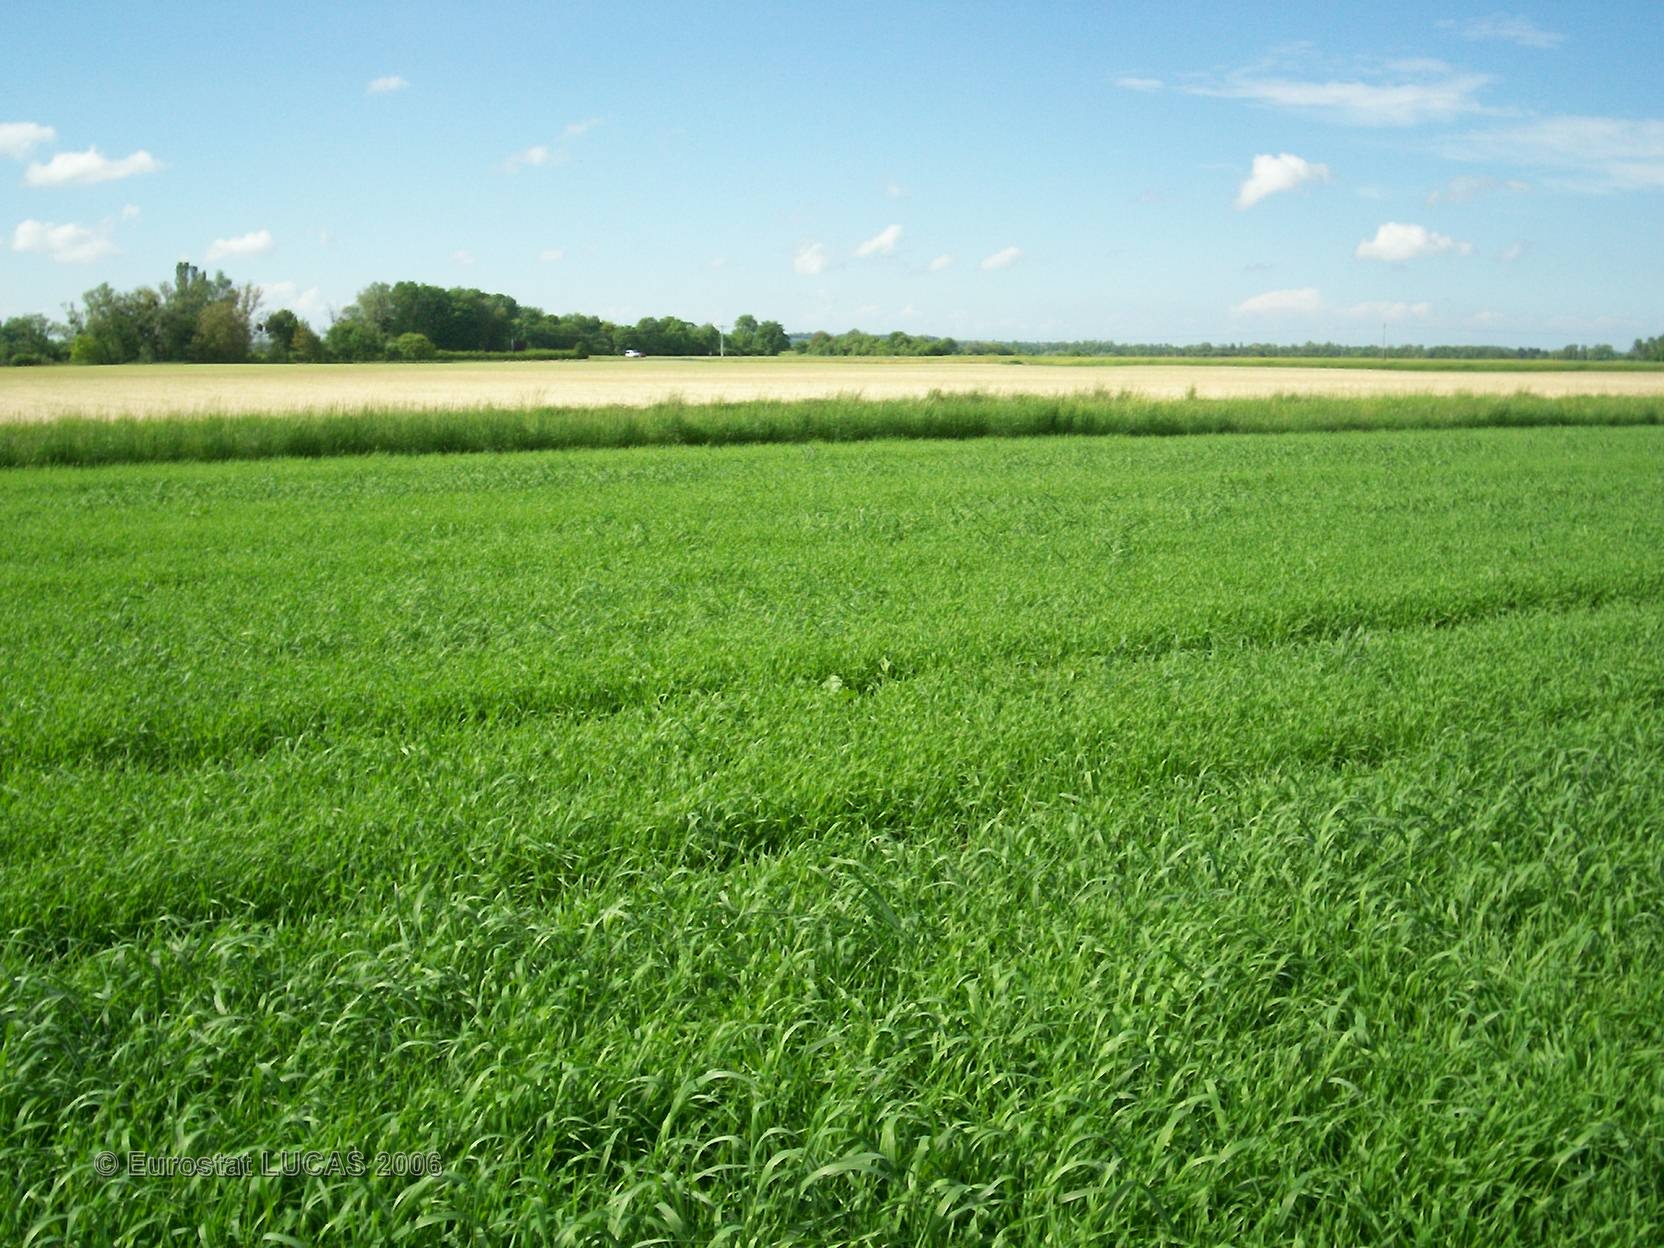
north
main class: Cropland
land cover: Barley
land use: Agriculture (excluding fallow land and kitchen gardens)
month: May
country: FR
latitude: 48.4109
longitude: 4.4988
